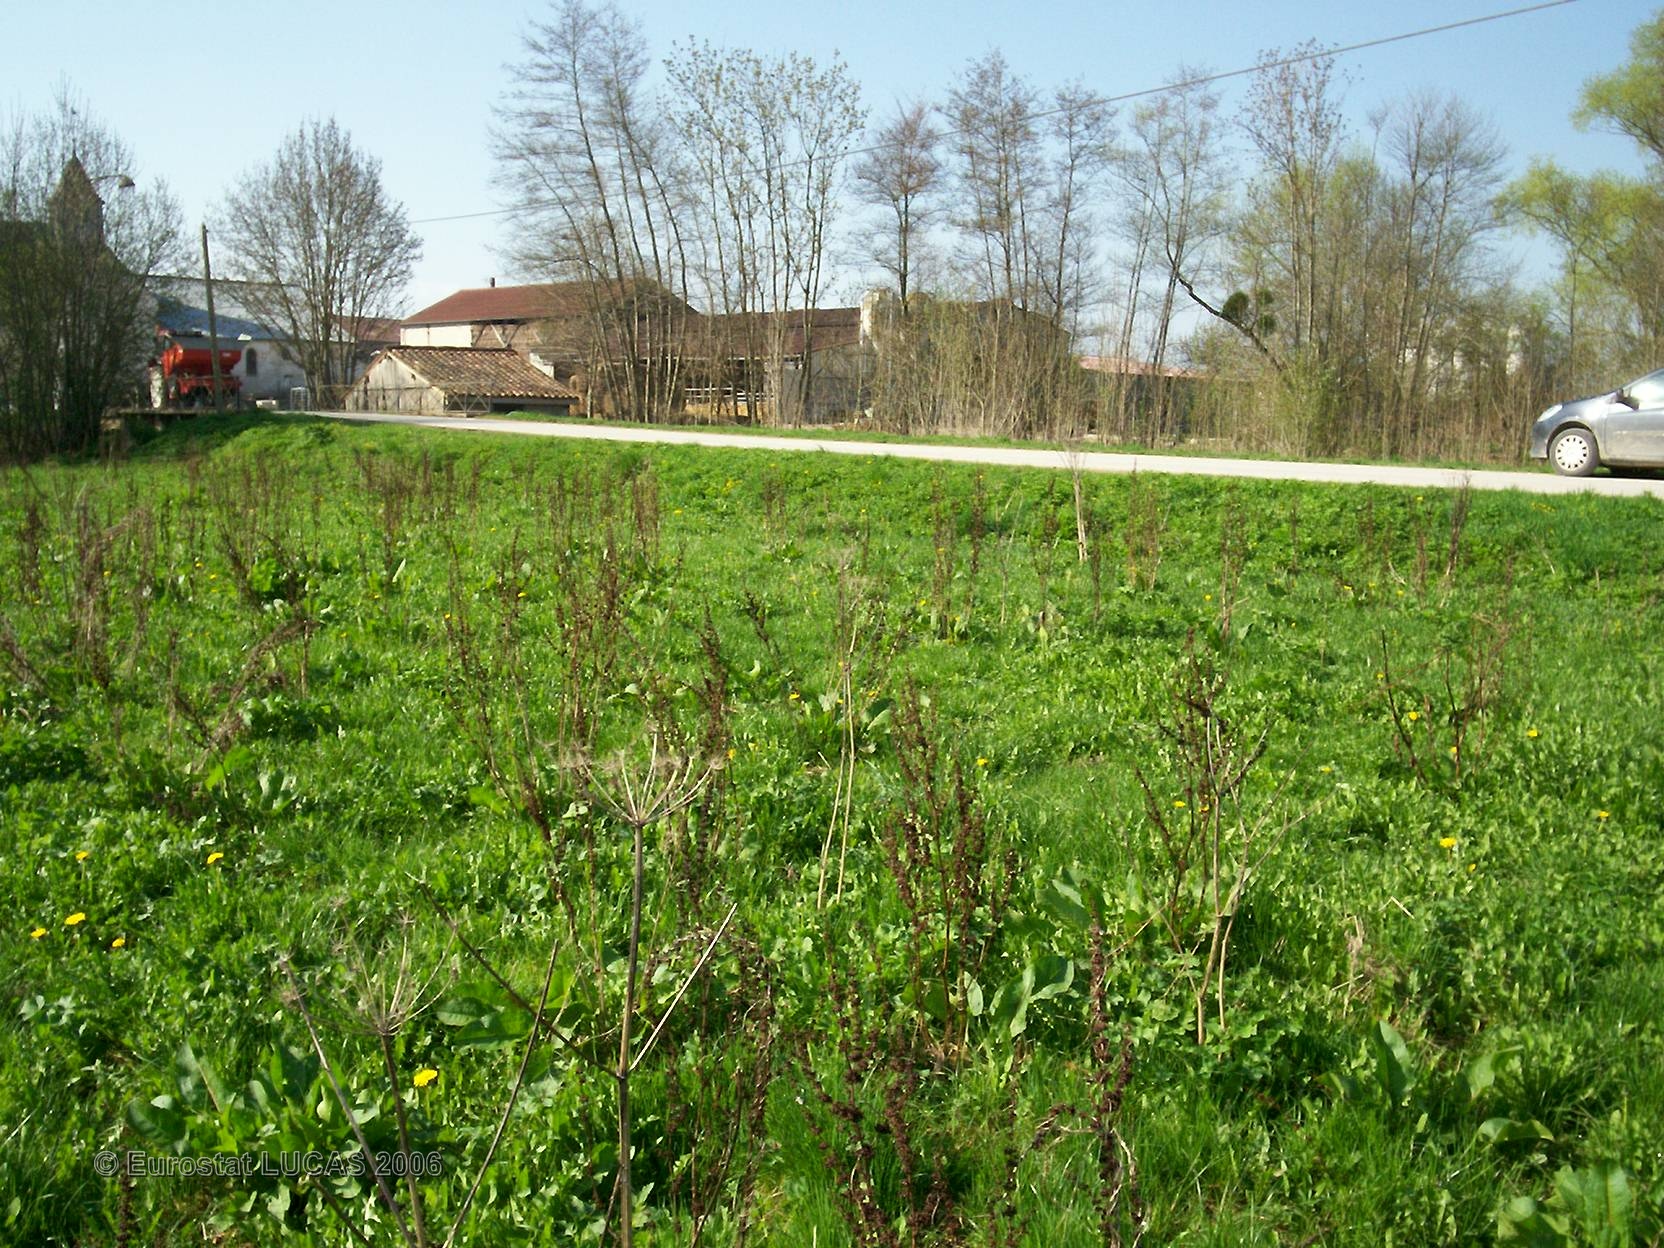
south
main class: Grassland
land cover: Grassland without tree/shrub cover
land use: Agriculture (excluding fallow land and kitchen gardens)
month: April
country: FR
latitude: 48.5171
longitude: 4.4600
